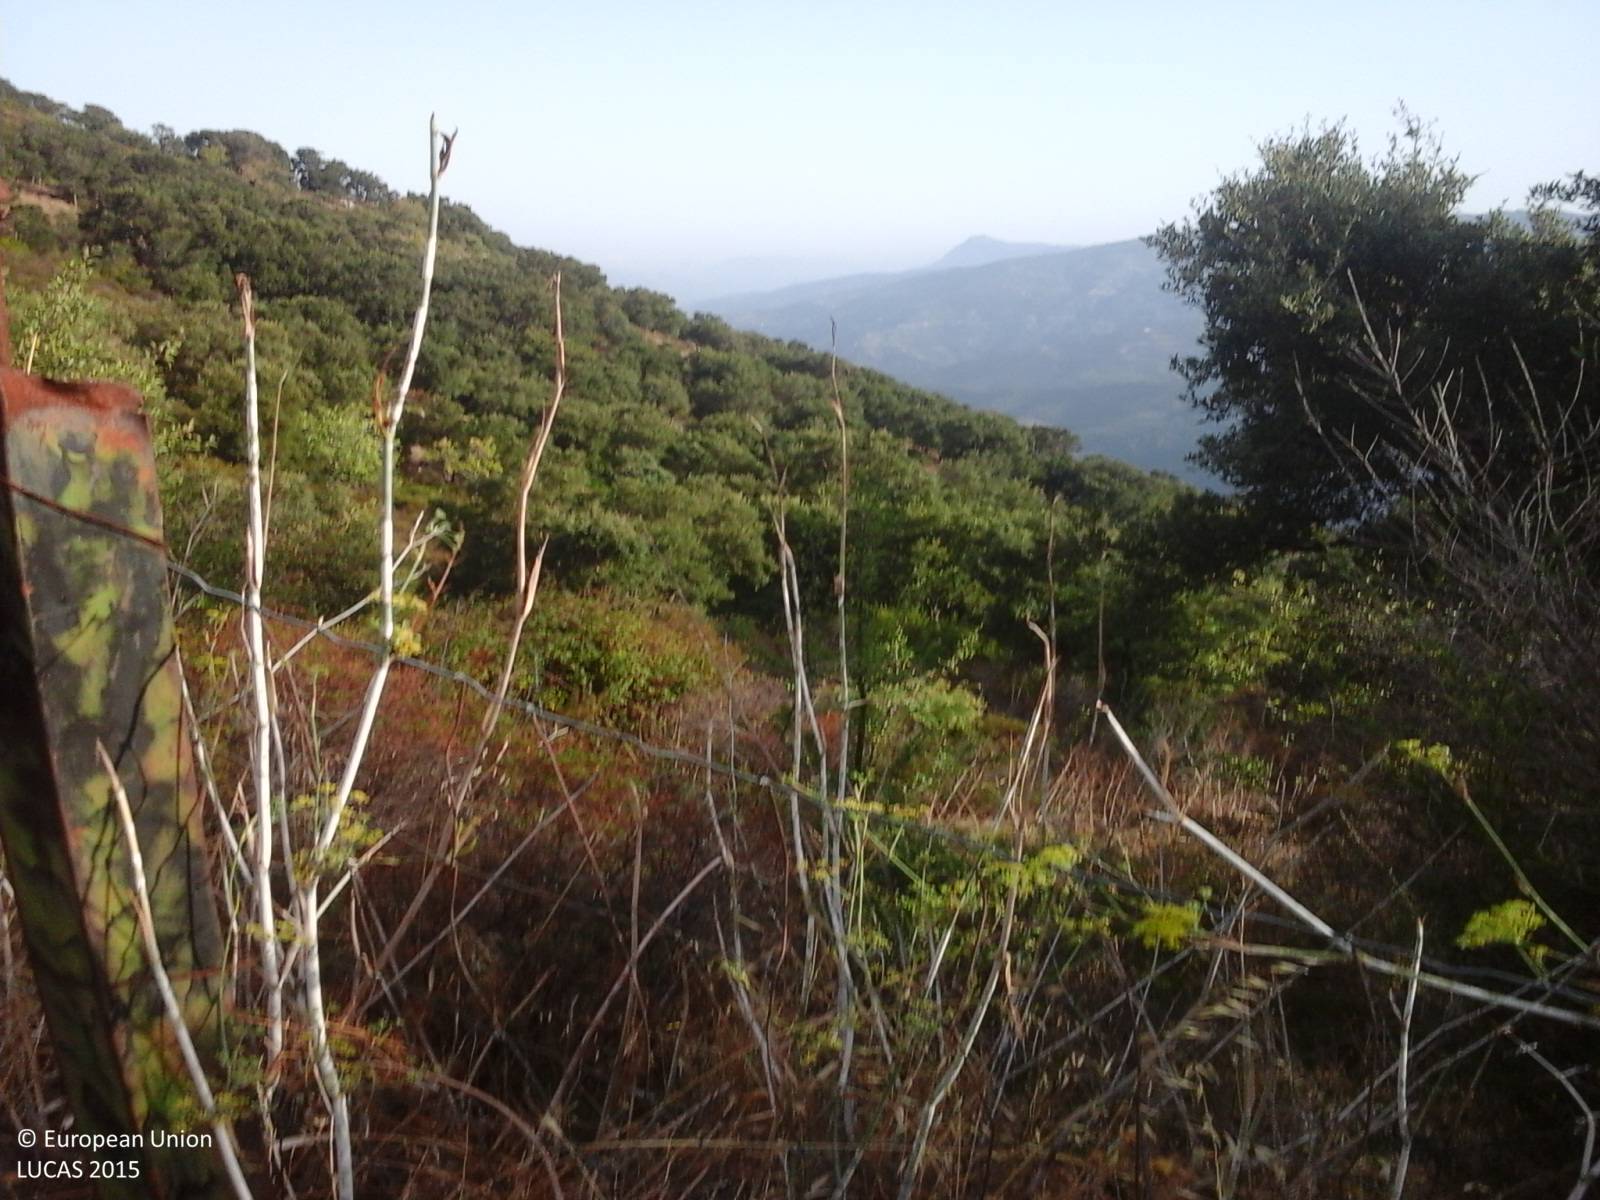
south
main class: Woodland
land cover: Broadleaved woodland
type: broadleaved evergreen forest
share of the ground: > 75 %
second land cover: Grassland without tree/shrub cover
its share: > 75 %
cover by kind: broadleaved forest trees 35 %, herbaceous plants 25 %, unconsolidated bare surface 20 %, shrubs 15 %, consolidated bare surface 5 %
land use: Agriculture (excluding fallow land and kitchen gardens)
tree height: > 5 m
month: September
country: IT
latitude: 39.8316
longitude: 9.5236
